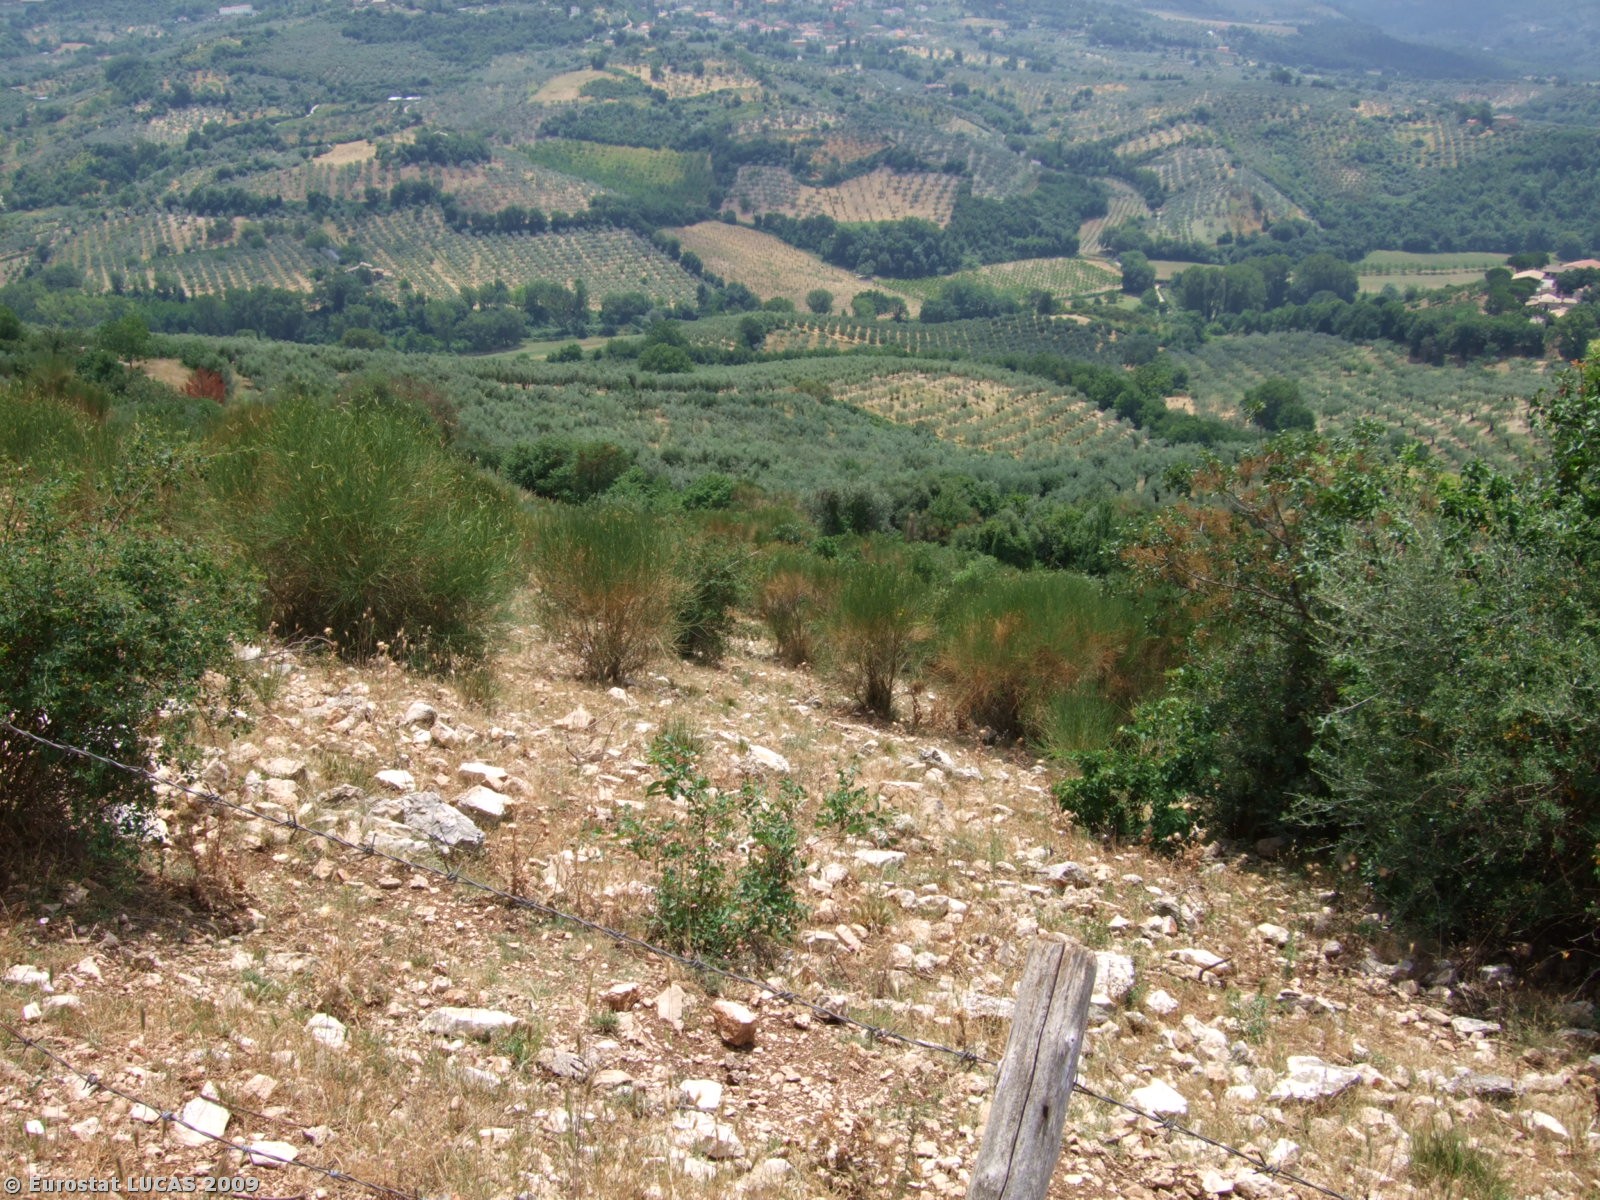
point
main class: Shrubland
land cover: Shrubland without tree cover
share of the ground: > 75 %
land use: Unused
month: June
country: IT
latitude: 42.1806
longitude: 12.8353
